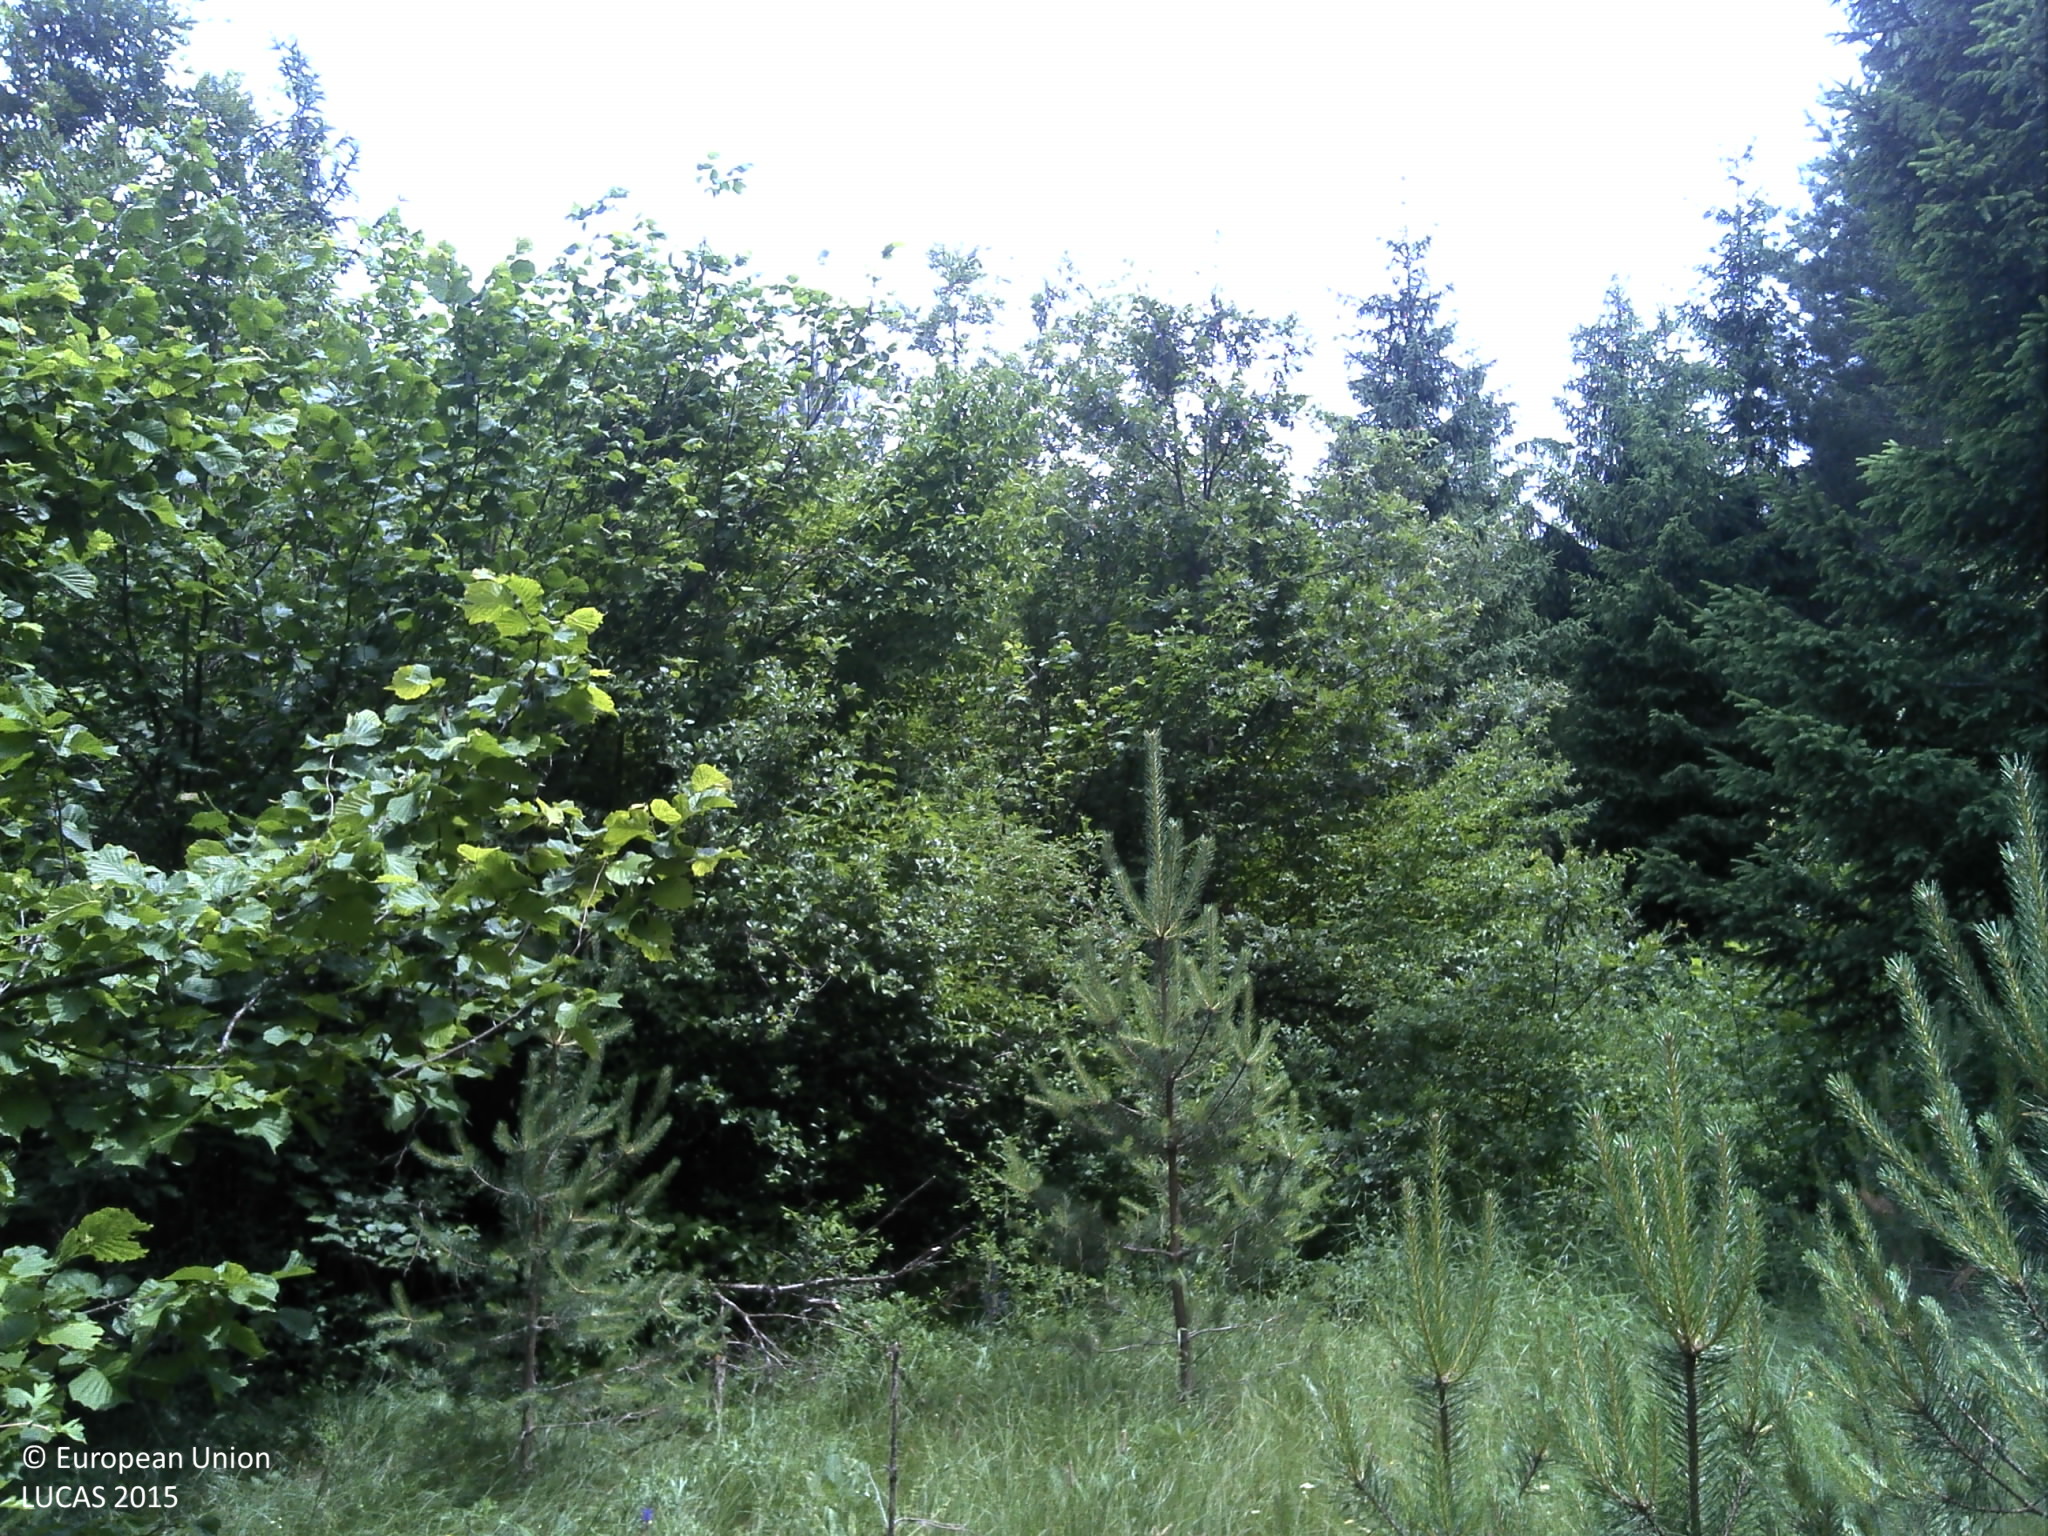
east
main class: Woodland
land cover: Pine dominated coniferous woodland
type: hemiboreal forest and nemoral coniferous forest and mixed broadleaved-coniferous forest
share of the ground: 50 - 75 %
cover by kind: coniferous forest trees 50 %, herbaceous plants 40 %, broadleaved forest trees 10 %
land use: Semi-natural and natural areas not in use
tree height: > 5 m
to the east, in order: Pine dominated coniferous woodland; Shrubland with sparse tree cover; Pine dominated coniferous woodland
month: June
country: HR
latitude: 44.4804
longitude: 16.0665
